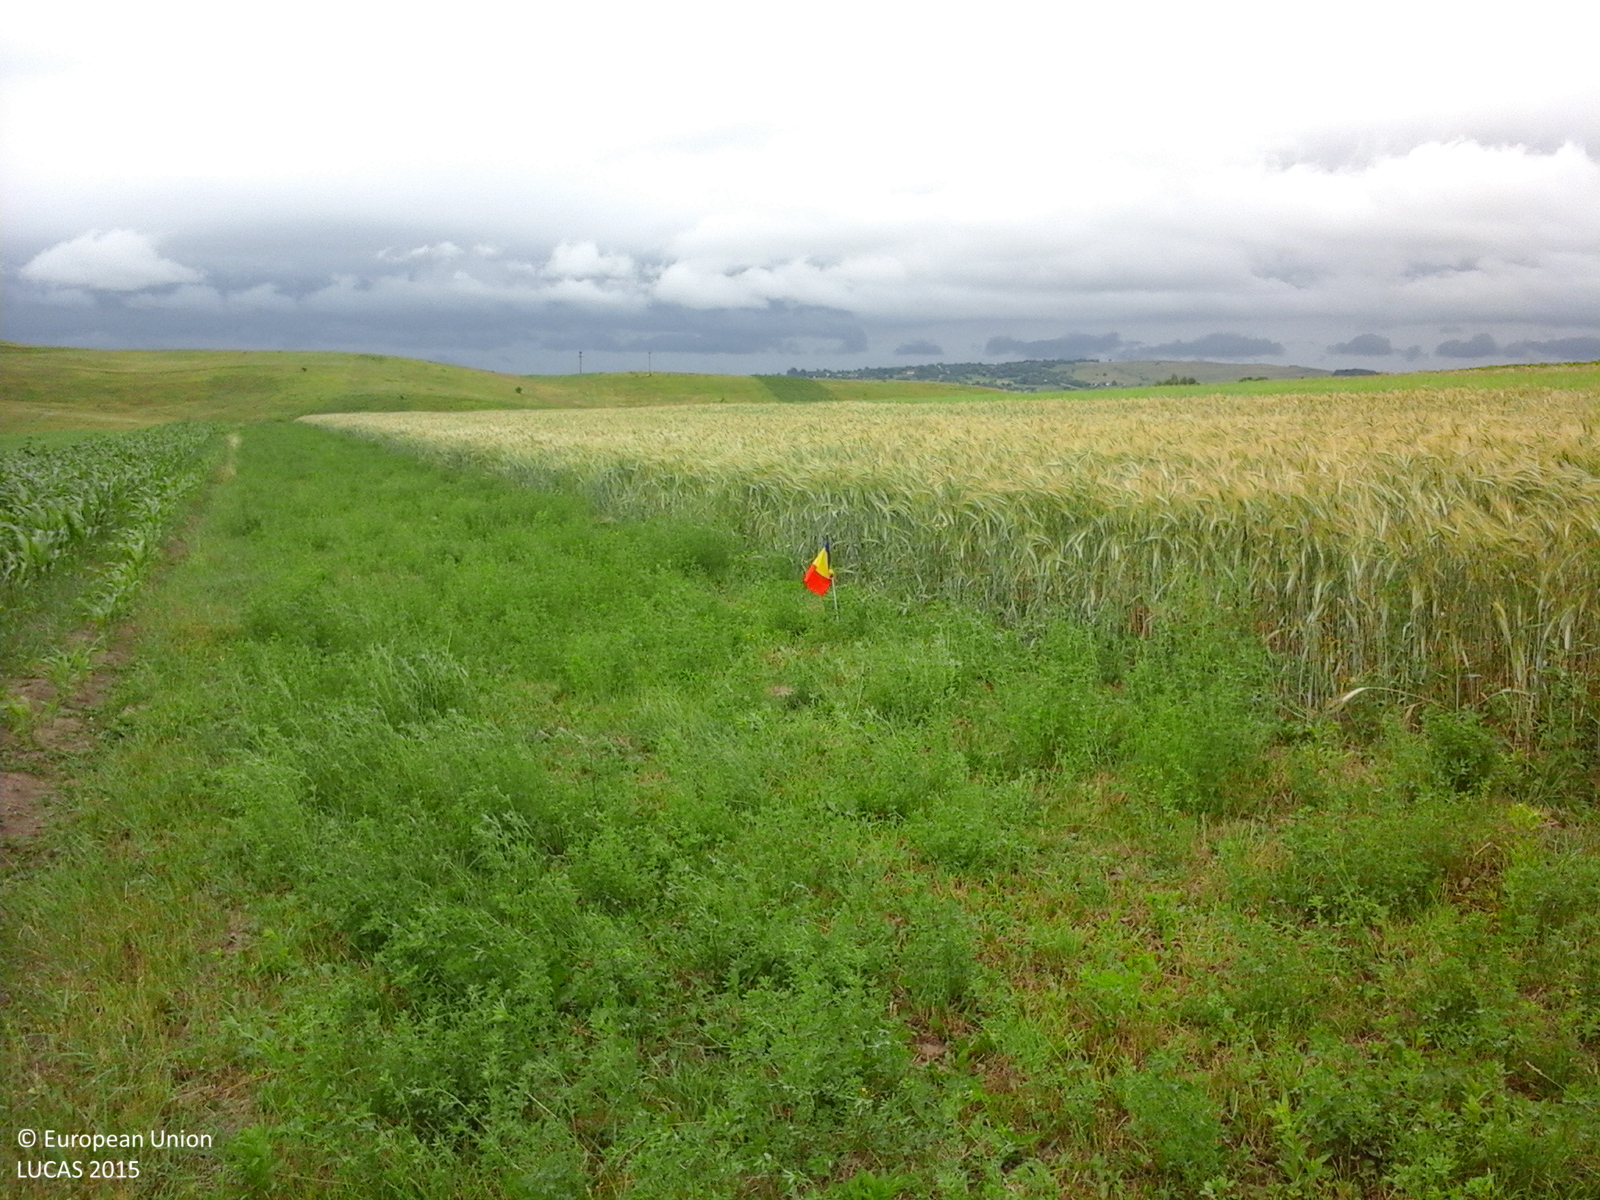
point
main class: Cropland
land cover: Lucerne
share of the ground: > 75 %
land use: Agriculture (excluding fallow land and kitchen gardens)
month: June
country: RO
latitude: 48.0856
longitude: 26.4009
